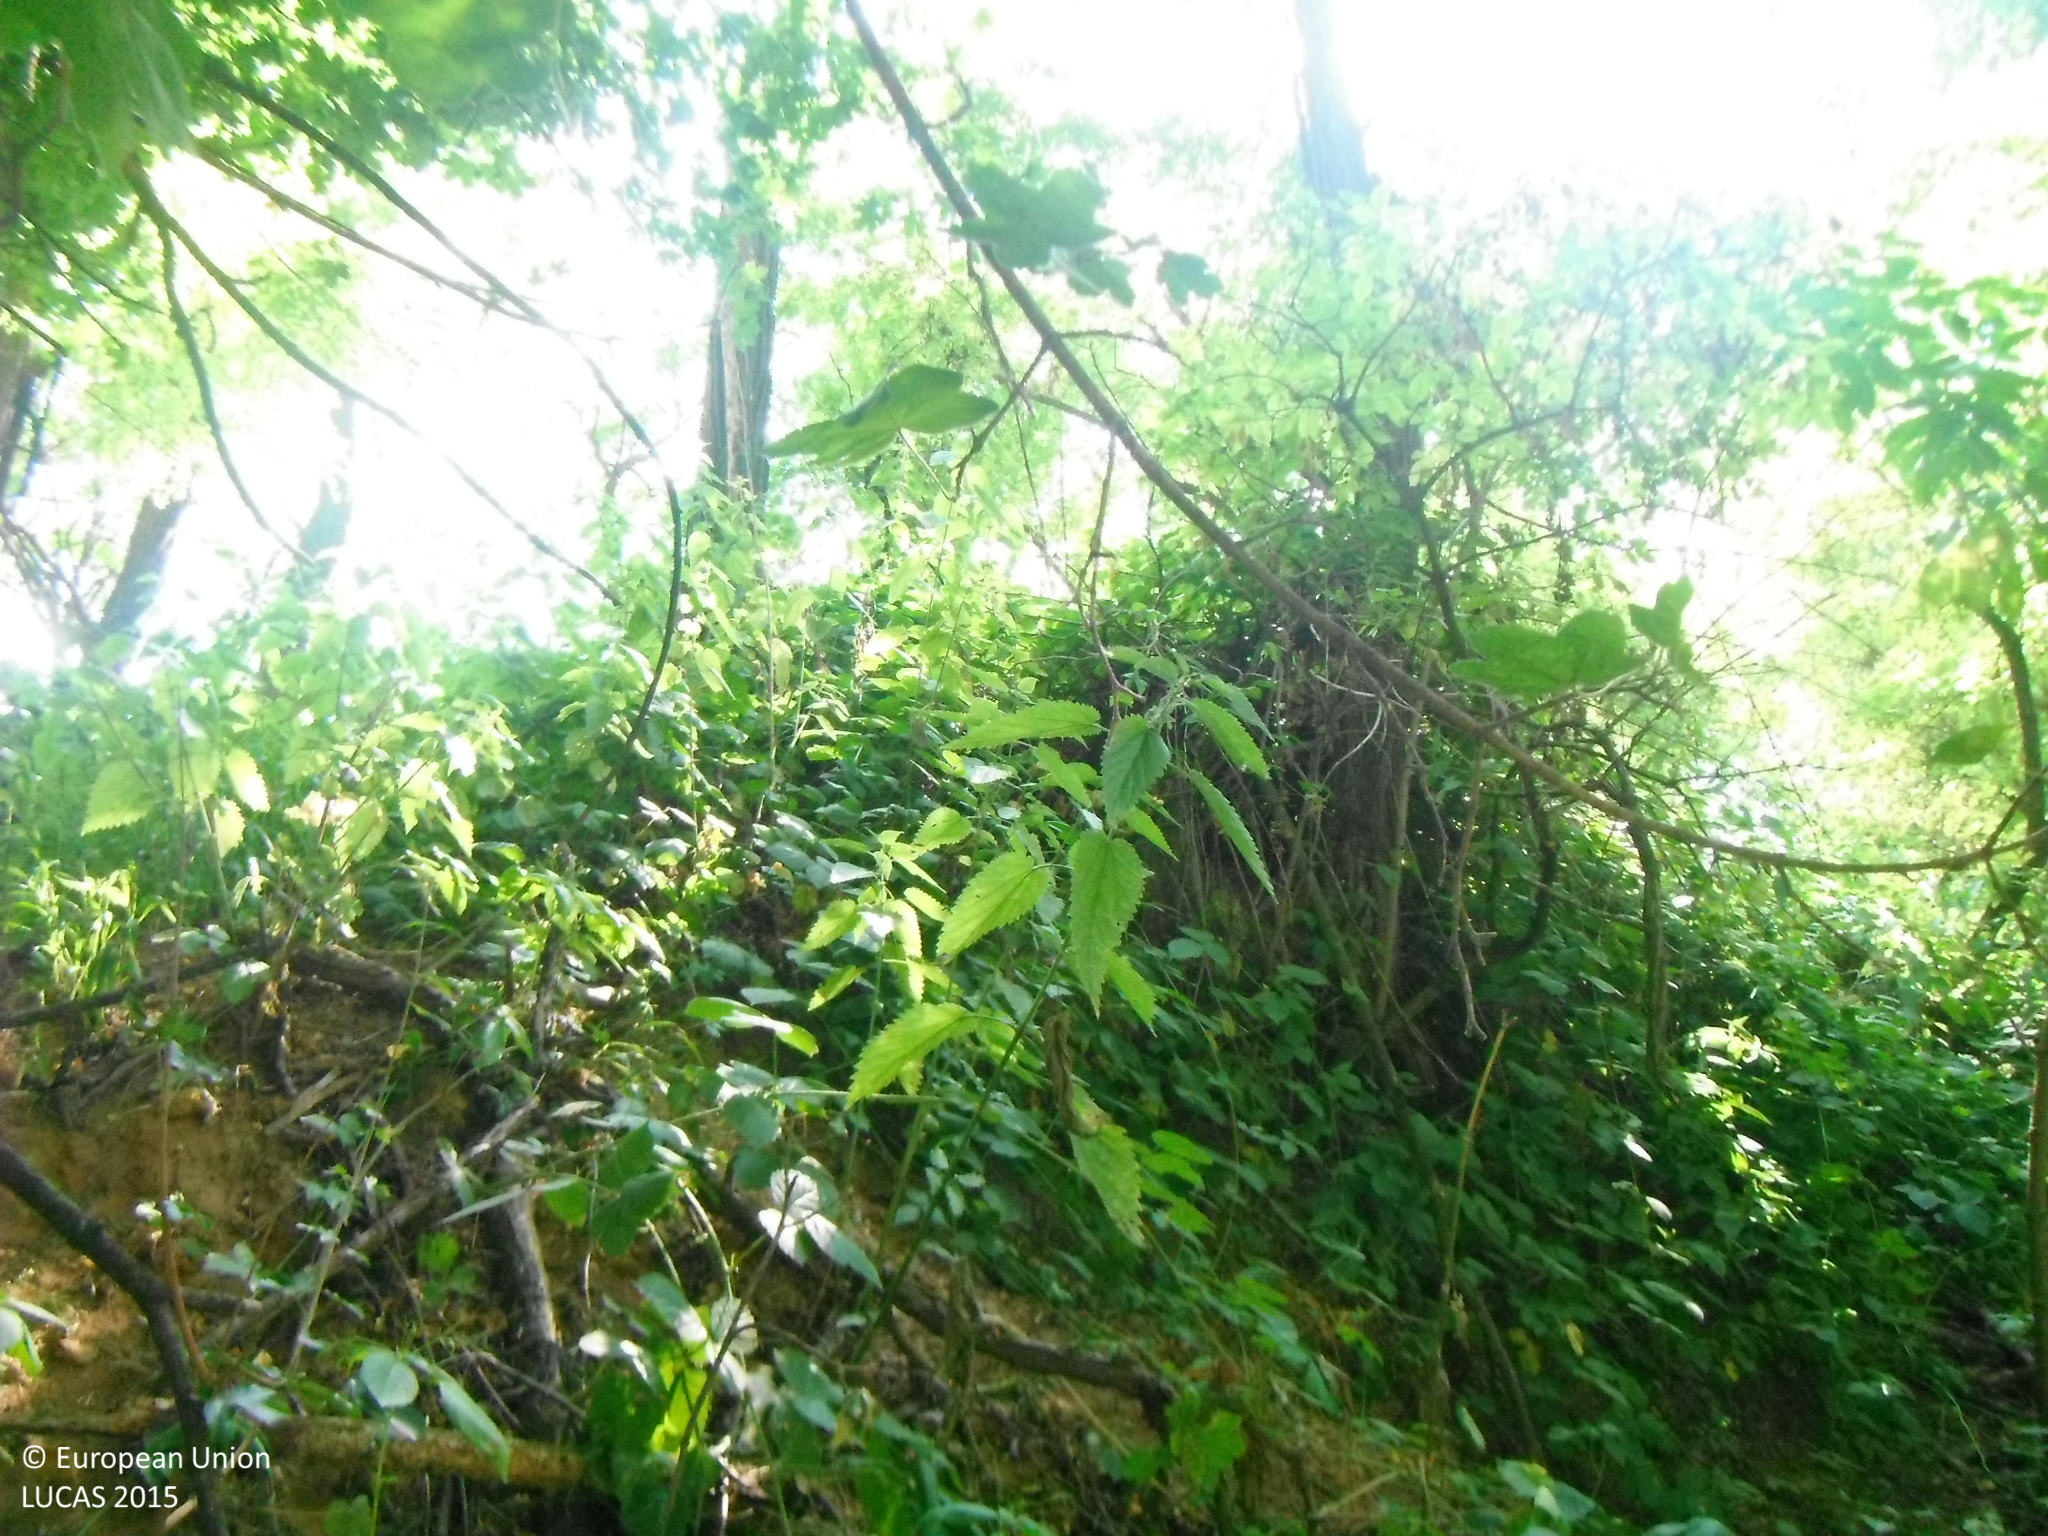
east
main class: Woodland
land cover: Broadleaved woodland
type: mesophytic deciduous forest
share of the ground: > 75 %
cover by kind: broadleaved forest trees 90 %, shrubs 5 %, herbaceous plants 5 %
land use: Semi-natural and natural areas not in use
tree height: > 5 m
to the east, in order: Broadleaved woodland; Shruby margins; Grassland without tree/shrub cover; Broadleaved woodland; Rivers and streams; Broadleaved woodland
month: July
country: SK
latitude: 48.6391
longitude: 17.4611
